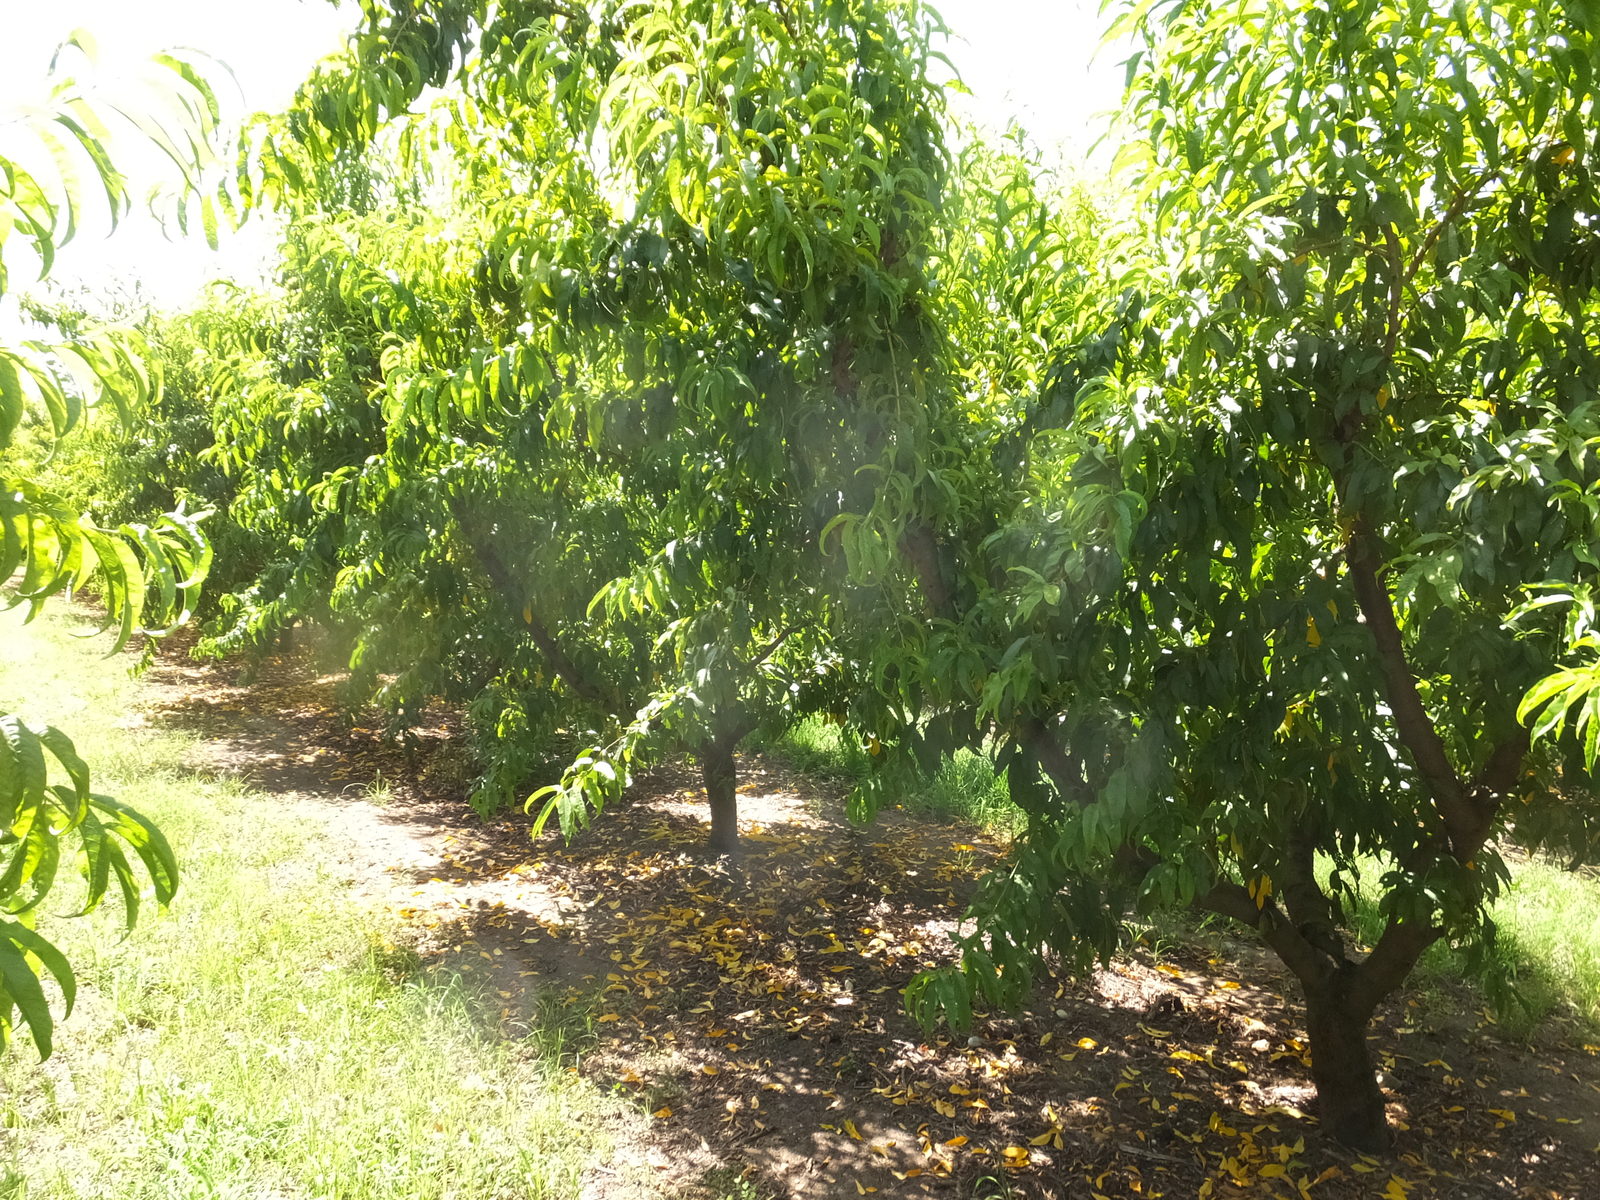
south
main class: Cropland
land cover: Other fruit trees and berries
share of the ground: > 75 %
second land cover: Spontaneously vegetated surfaces
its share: 10 - 25 %
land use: Agriculture (excluding fallow land and kitchen gardens)
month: July
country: ES
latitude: 41.5145
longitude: 0.4860
